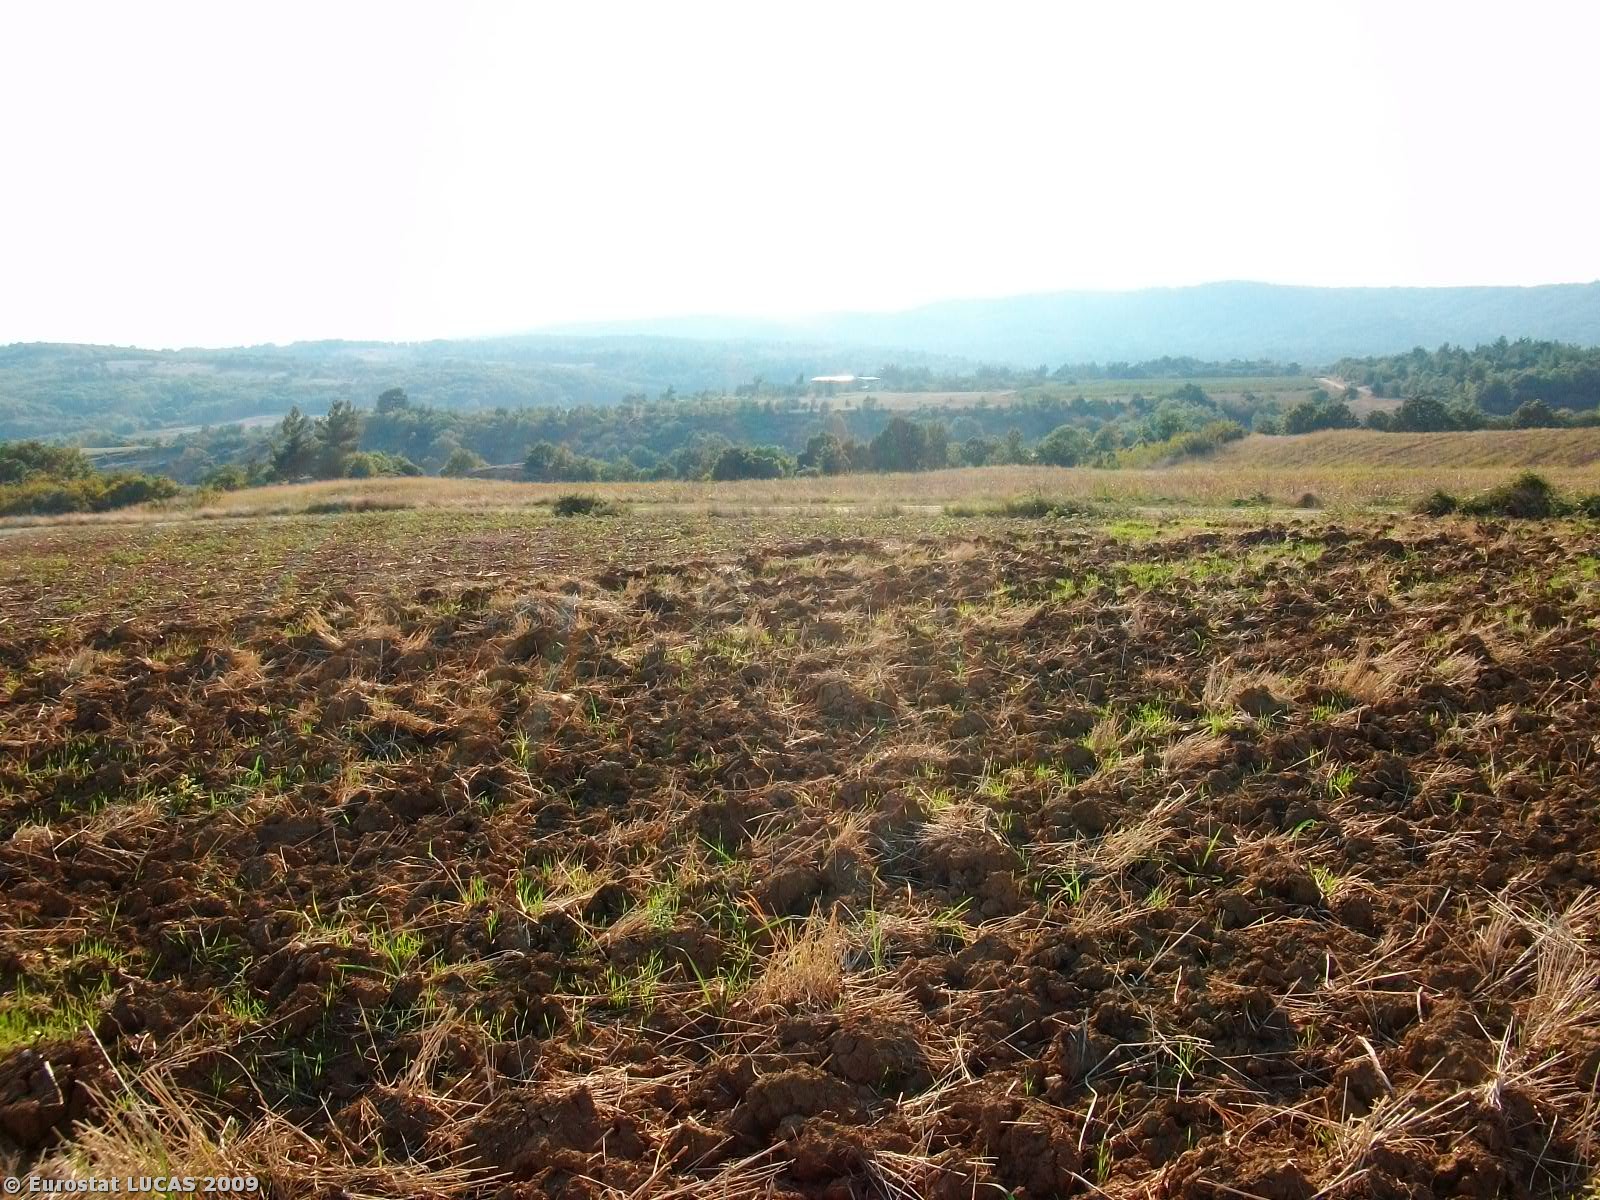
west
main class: Cropland
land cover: Common wheat
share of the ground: < 10 %
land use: Agriculture (excluding fallow land and kitchen gardens)
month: September
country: GR
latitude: 41.1811
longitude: 26.2699
